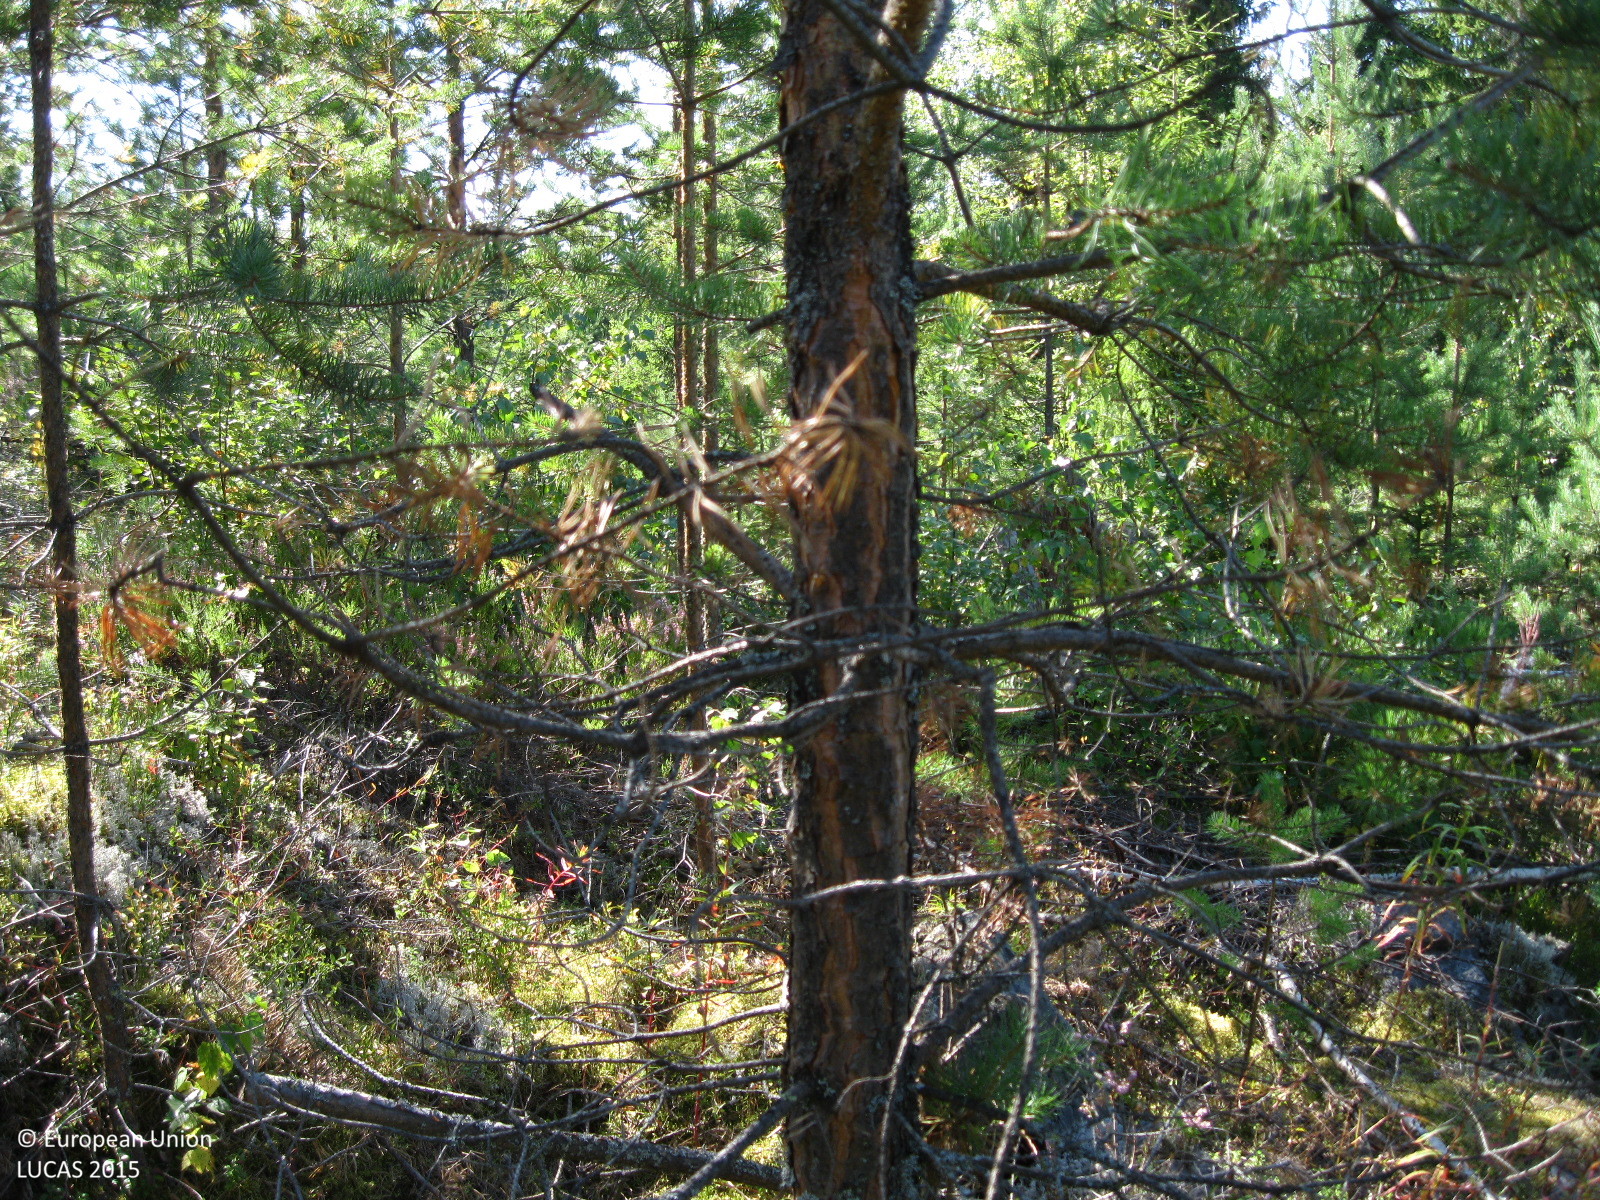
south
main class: Woodland
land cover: Pine dominated coniferous woodland
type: boreal forest
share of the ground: 50 - 75 %
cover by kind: coniferous forest trees 60 %, shrubs 25 %, broadleaved forest trees 5 %, herbaceous plants 5 %, lichens and mosses 5 %
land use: Forestry
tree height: < 5 m
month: August
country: FI
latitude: 61.2706
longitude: 25.1272
